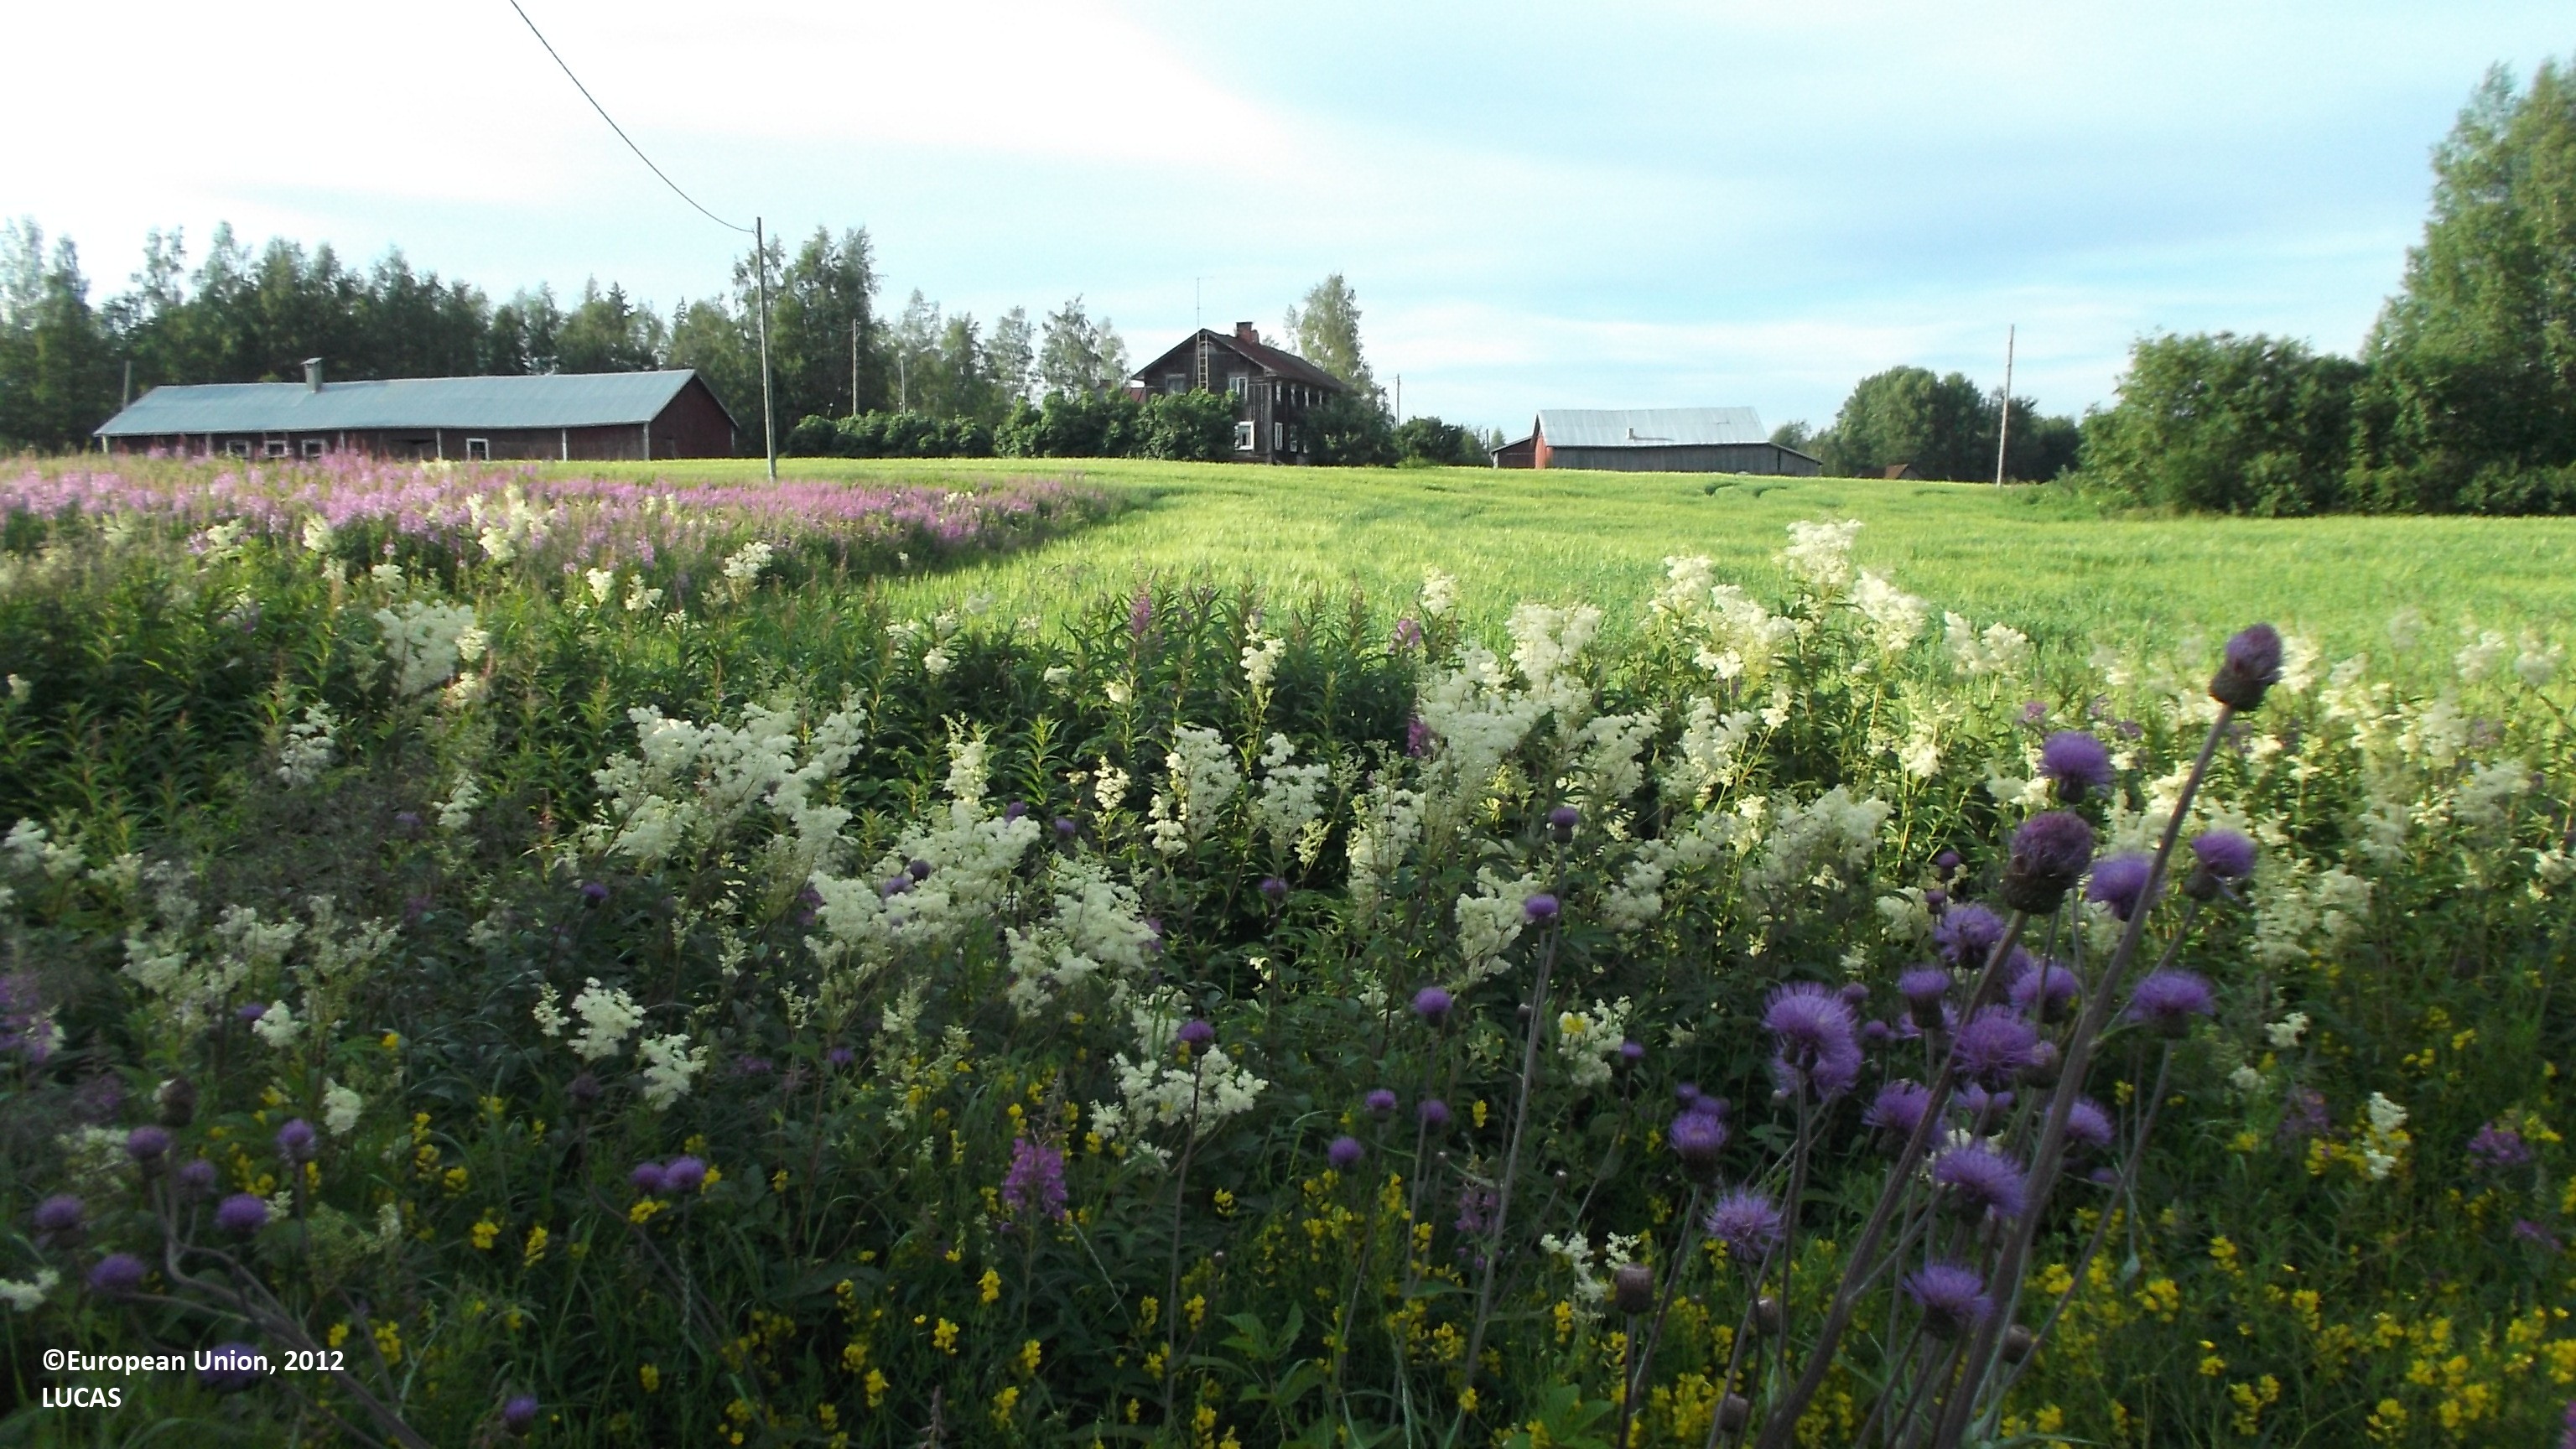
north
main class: Grassland
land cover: Grassland without tree/shrub cover
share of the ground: 50 - 75 %
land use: Fallow land
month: July
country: FI
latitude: 63.6430
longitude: 24.0199
